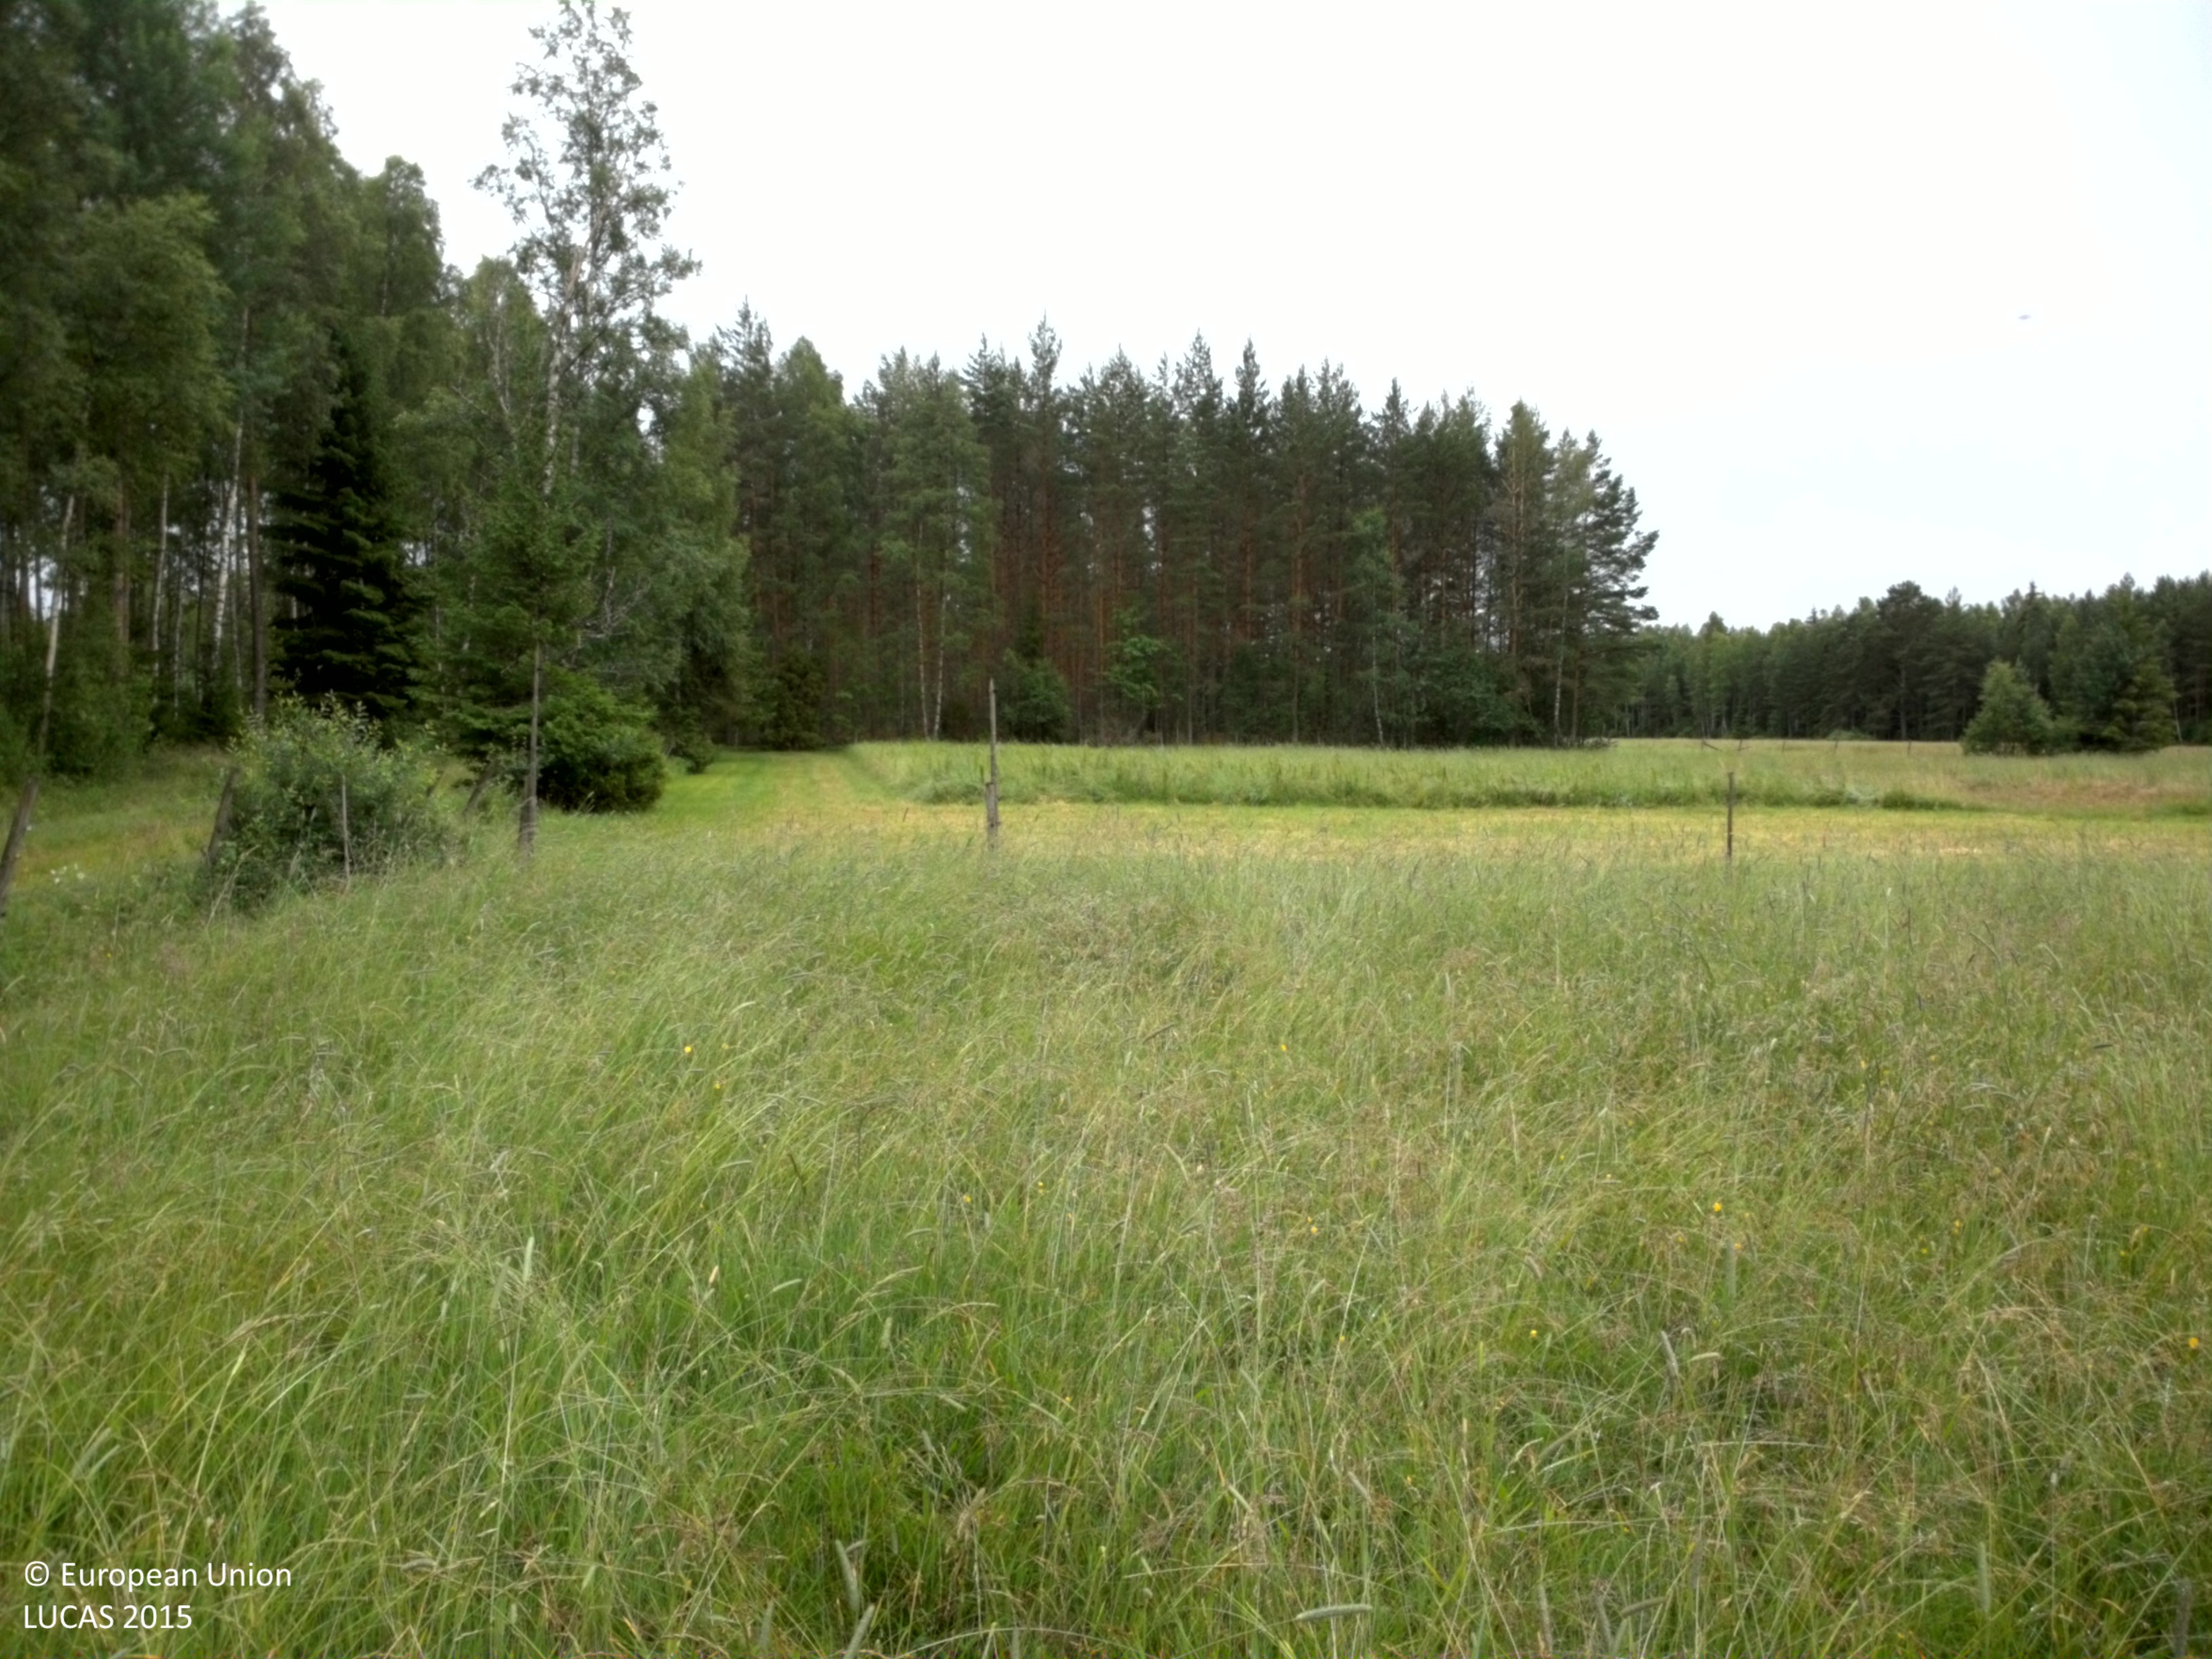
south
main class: Grassland
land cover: Grassland without tree/shrub cover
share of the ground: > 75 %
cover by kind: herbaceous plants 100 %
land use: Agriculture (excluding fallow land and kitchen gardens)
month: July
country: SE
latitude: 58.4656
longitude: 14.0221
